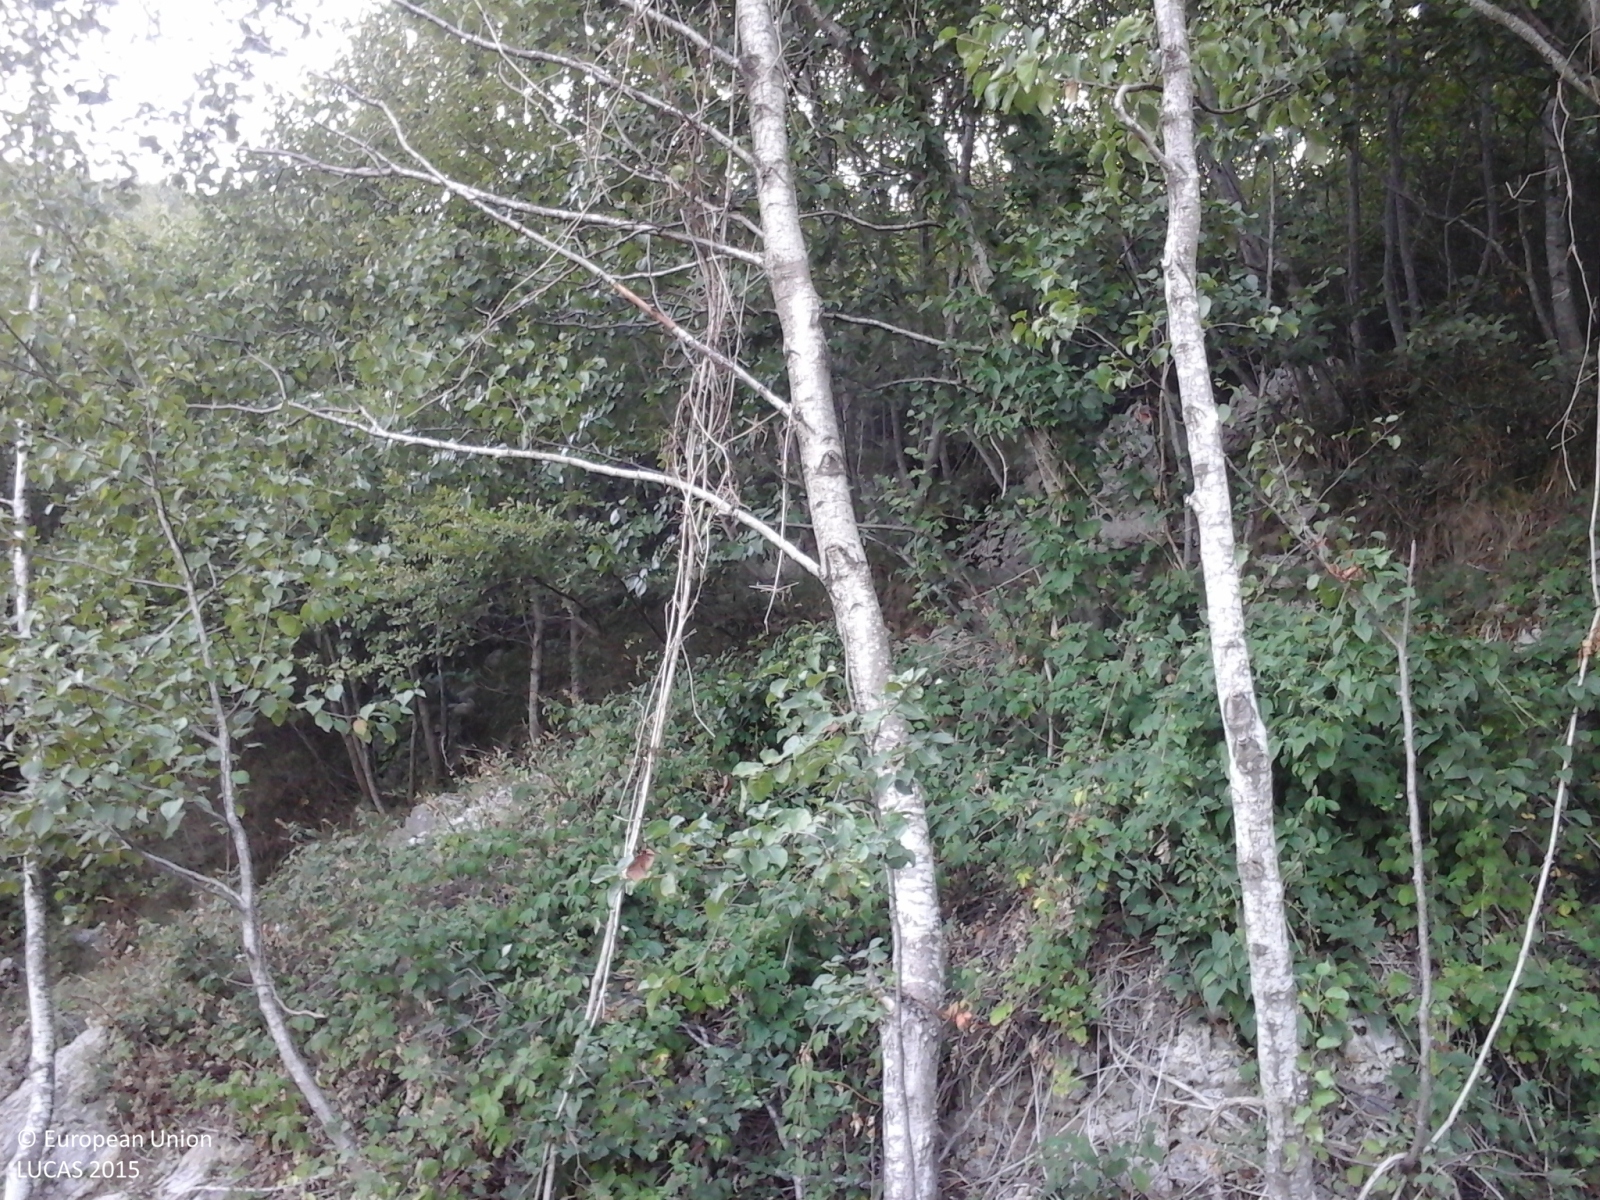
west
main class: Woodland
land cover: Broadleaved woodland
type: thermophilous deciduous forest
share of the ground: > 75 %
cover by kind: broadleaved forest trees 100 %
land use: Forestry
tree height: > 5 m
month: September
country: IT
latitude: 40.6688
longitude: 14.5586
